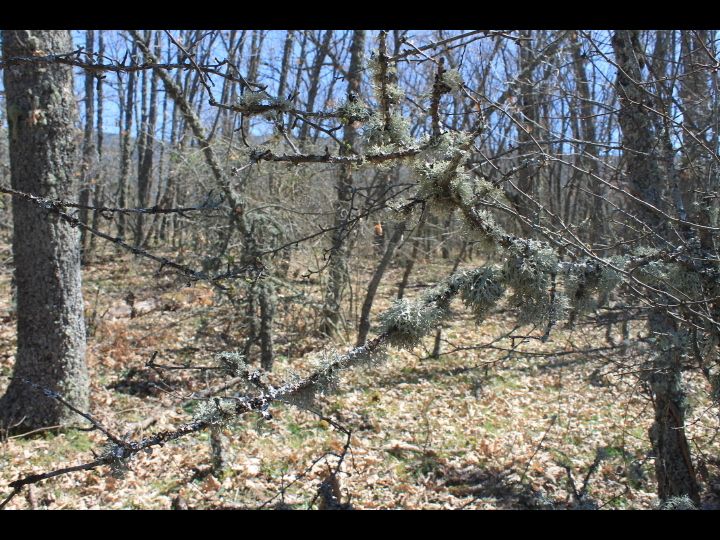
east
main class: Woodland
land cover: Broadleaved woodland
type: thermophilous deciduous forest
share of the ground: > 75 %
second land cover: Grassland without tree/shrub cover
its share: 10 - 25 %
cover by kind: broadleaved forest trees 90 %, herbaceous plants 5 %, lichens and mosses 5 %
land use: Forestry
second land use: Agriculture (excluding fallow land and kitchen gardens)
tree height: > 5 m
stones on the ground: < 10 %
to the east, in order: Broadleaved woodland; Grassland without tree/shrub cover; Grassland with sparse tree/shrub cover; Broadleaved woodland; Rock outcrops; Shrubland with sparse tree cover; Broadleaved woodland; Rivers and streams; Grassland without tree/shrub cover
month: April
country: ES
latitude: 40.9076
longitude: -3.9975
